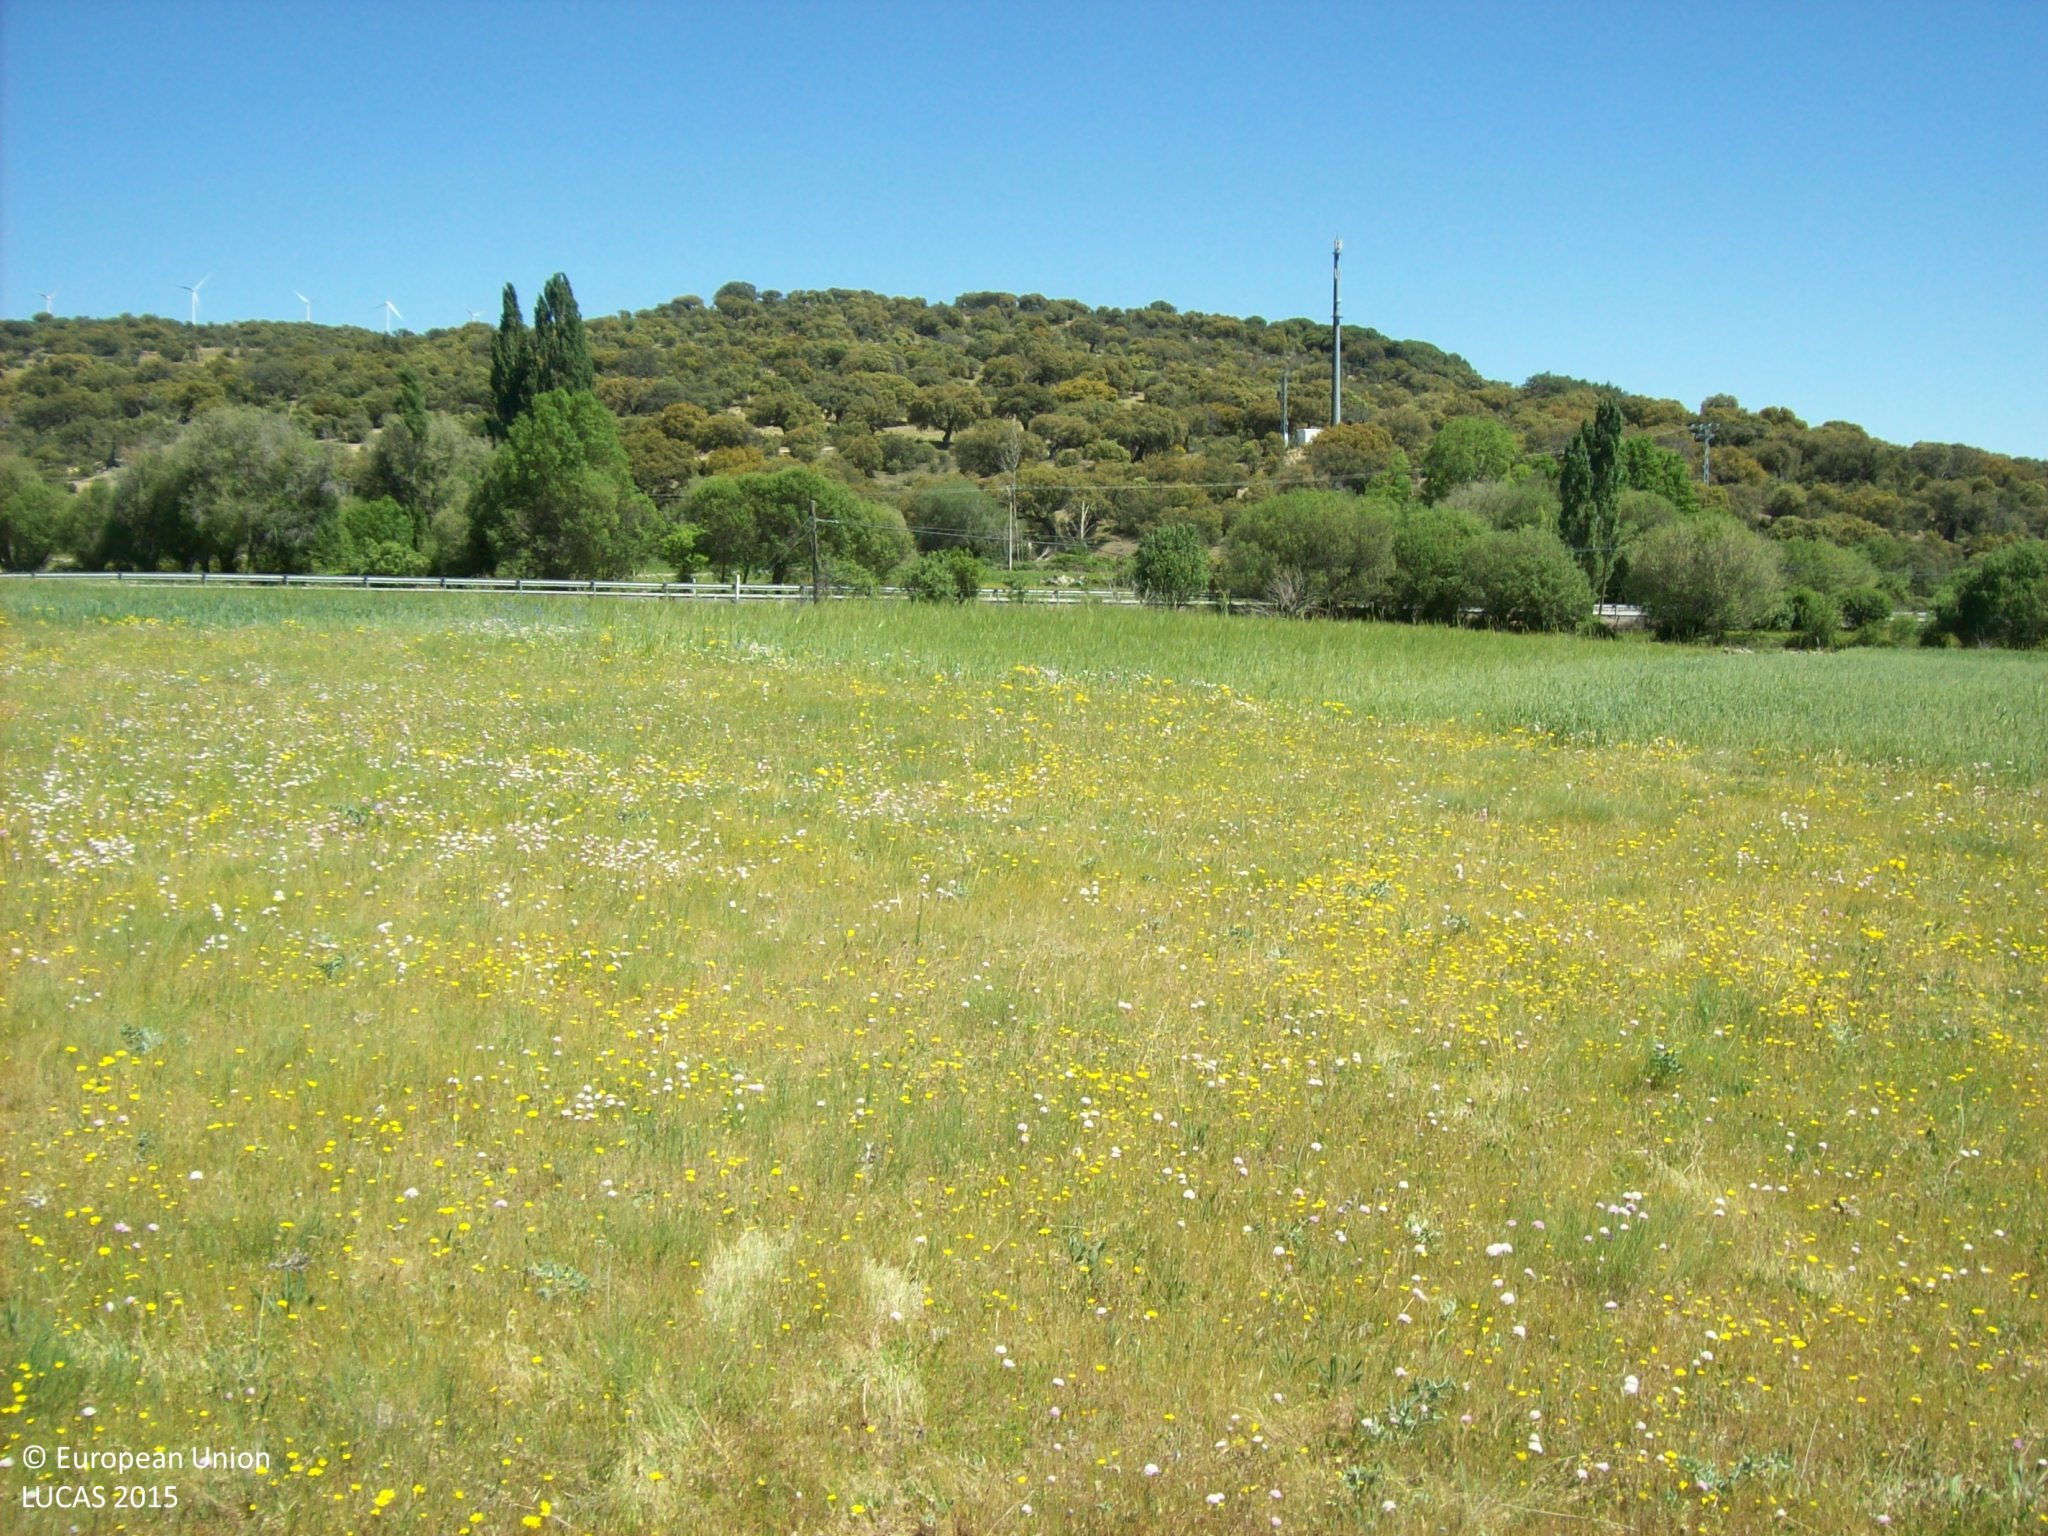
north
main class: Grassland
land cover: Grassland without tree/shrub cover
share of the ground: > 75 %
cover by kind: herbaceous plants 90 %
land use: Abandoned areas
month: May
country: ES
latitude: 40.5645
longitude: -5.0725
